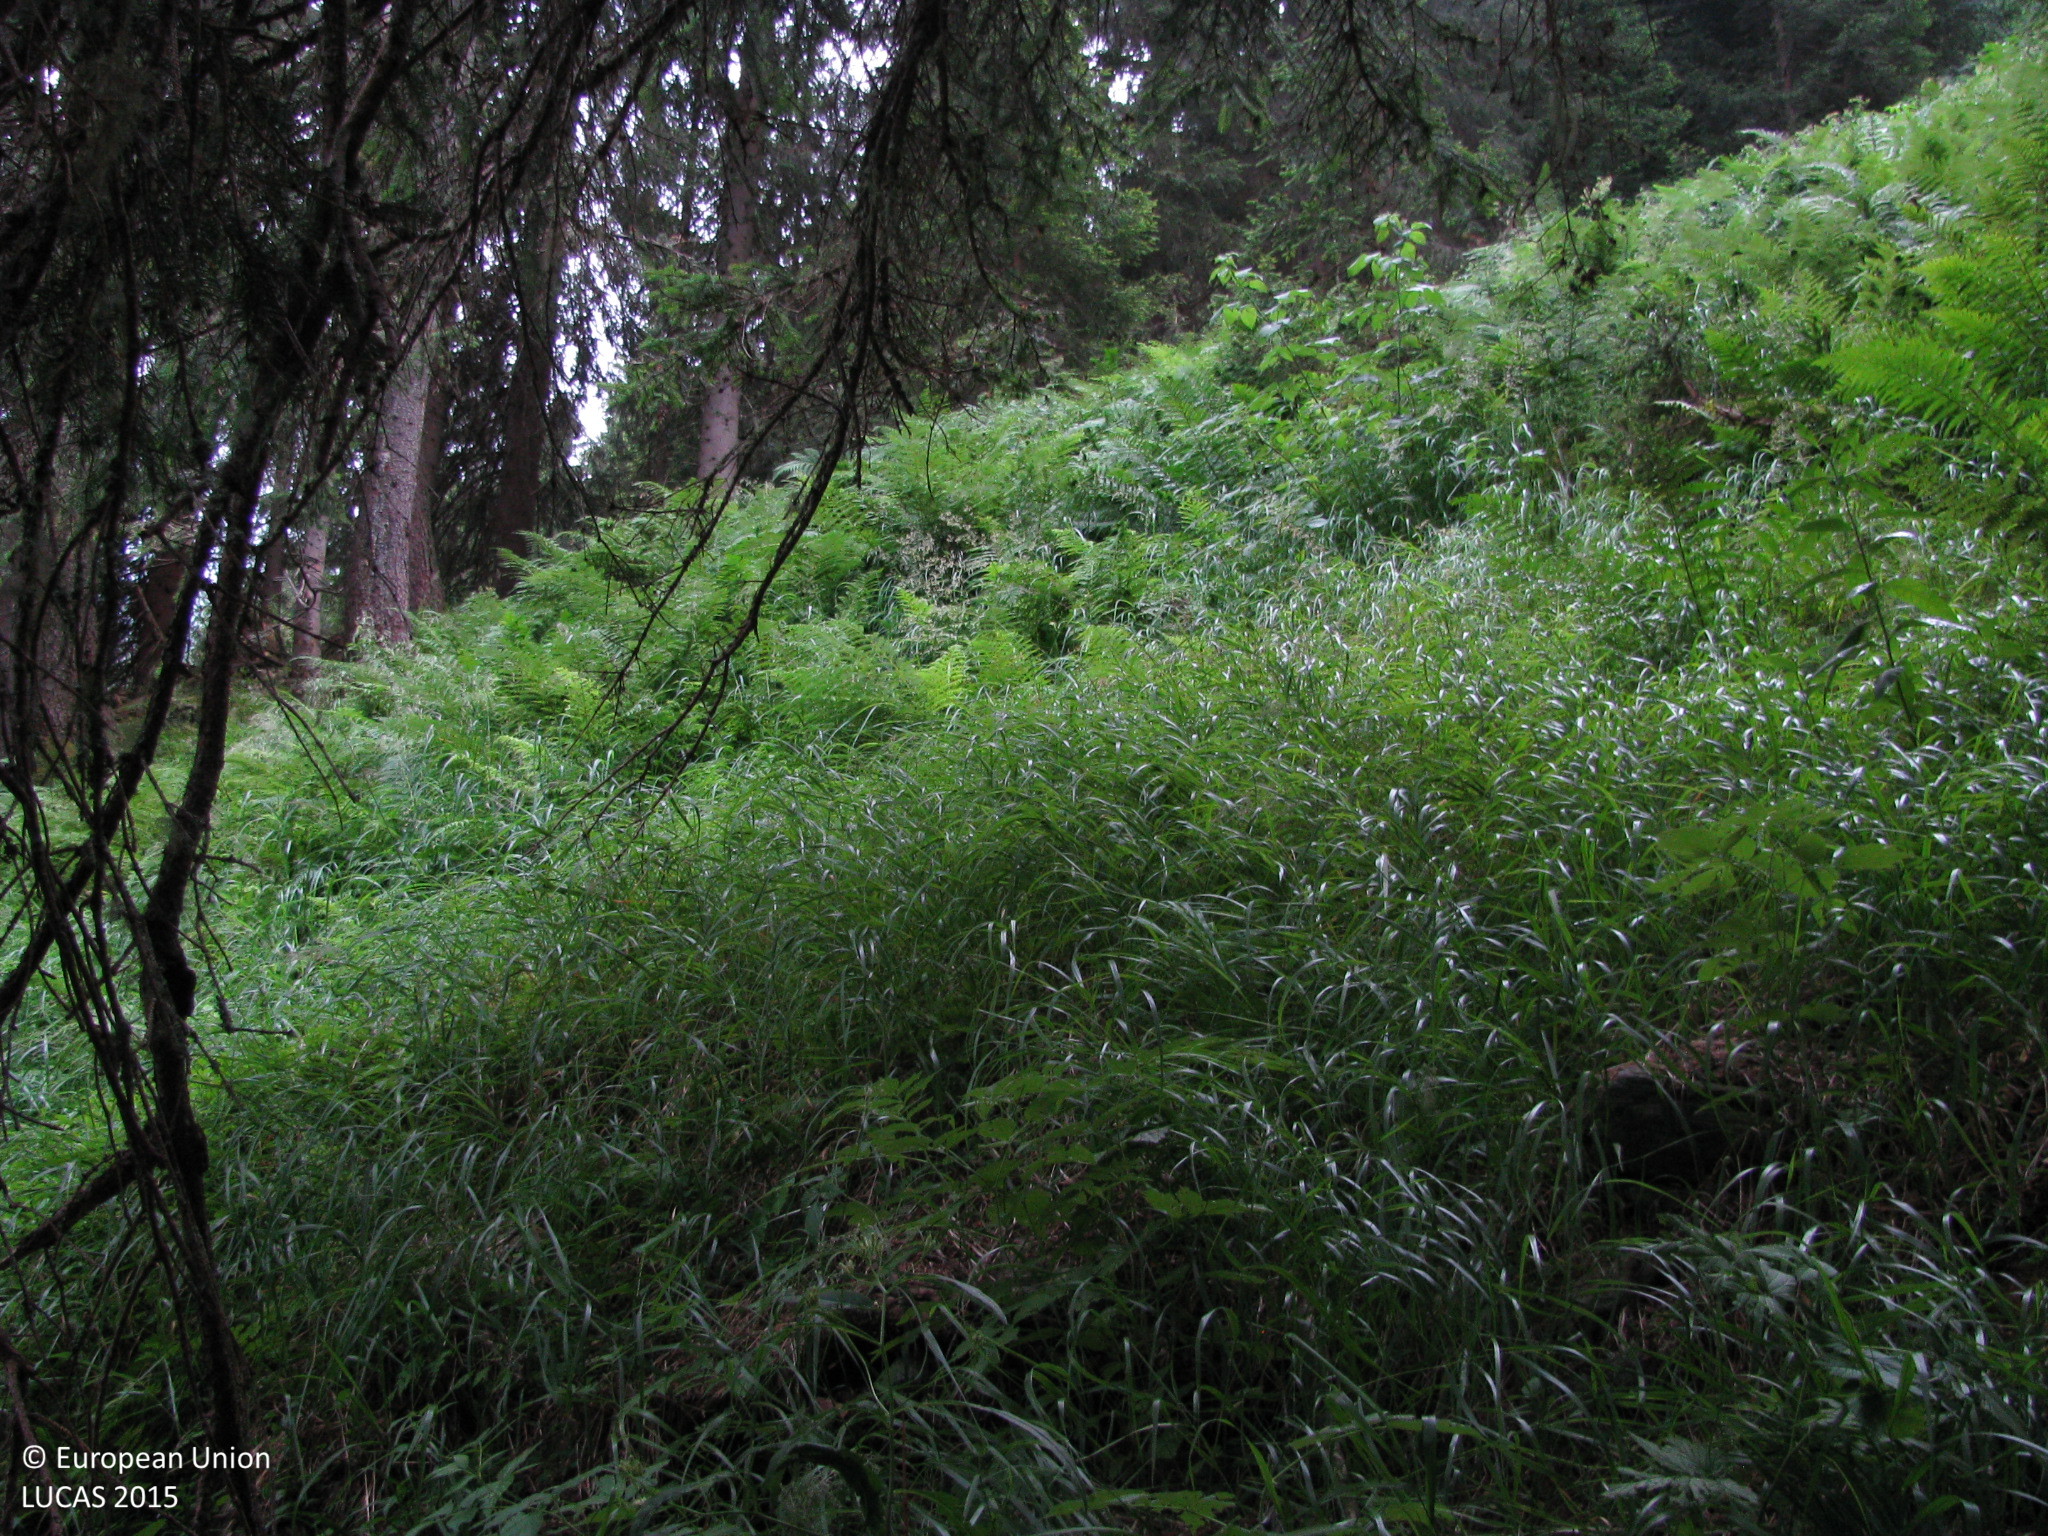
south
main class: Woodland
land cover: Spruce dominated coniferous woodland
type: alpine coniferous forest
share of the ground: > 75 %
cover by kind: coniferous forest trees 75 %, herbaceous plants 15 %, lichens and mosses 5 %, unconsolidated bare surface 5 %
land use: Forestry
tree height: > 5 m
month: July
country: AT
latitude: 46.6788
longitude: 12.6513
